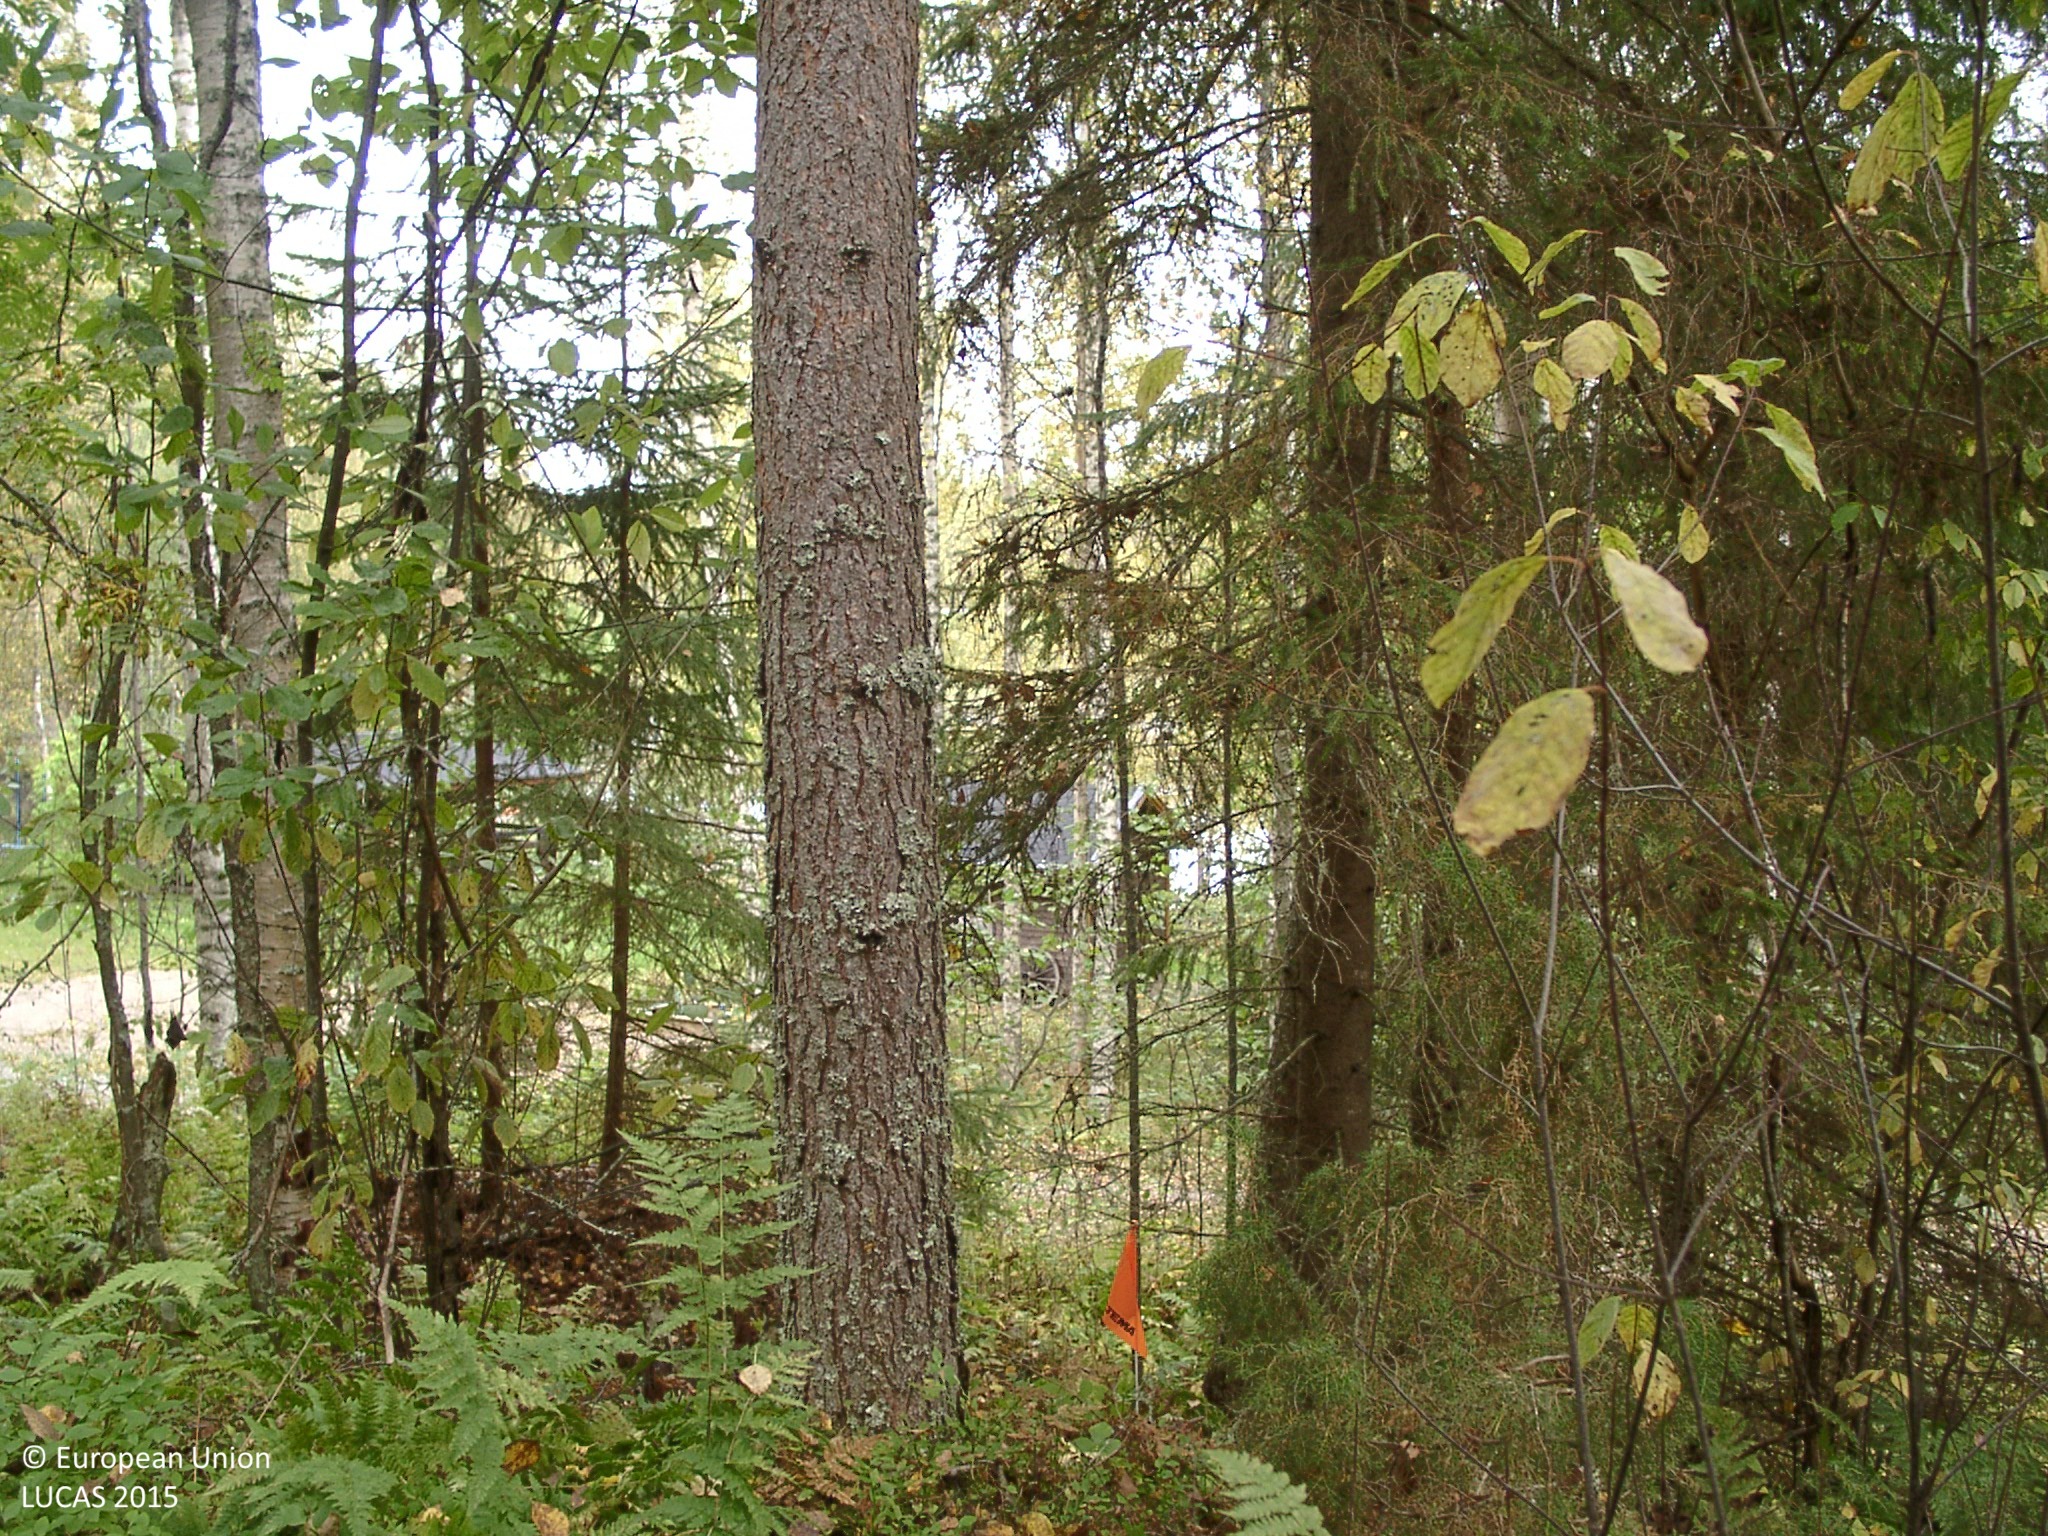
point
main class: Woodland
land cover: Spruce dominated mixed woodland
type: boreal forest
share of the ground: 50 - 75 %
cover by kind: broadleaved forest trees 35 %, coniferous forest trees 30 %, herbaceous plants 20 %, shrubs 10 %, unconsolidated bare surface 5 %
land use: Forestry
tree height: > 5 m
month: September
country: FI
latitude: 62.8715
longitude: 25.8624
